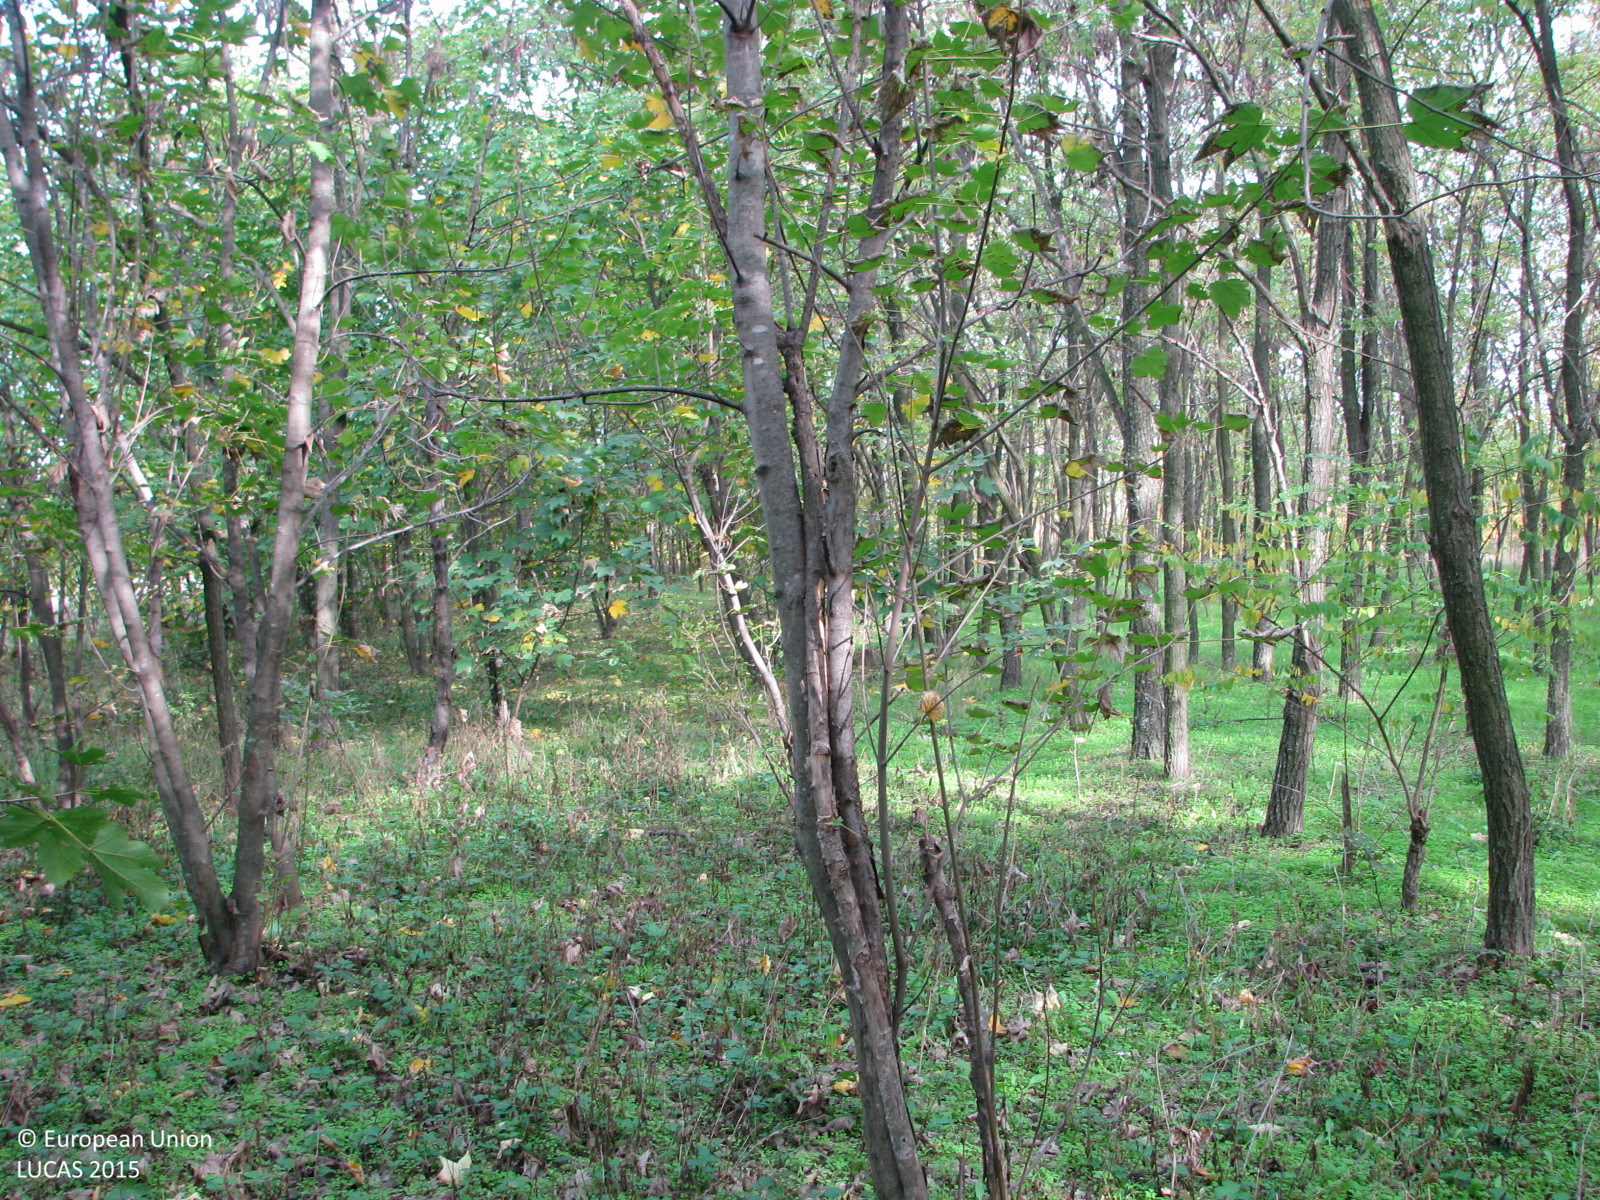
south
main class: Woodland
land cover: Broadleaved woodland
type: mesophytic deciduous forest
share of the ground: 50 - 75 %
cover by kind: broadleaved forest trees 70 %, herbaceous plants 30 %
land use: Forestry
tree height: > 5 m
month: October
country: BG
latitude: 42.4707
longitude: 26.6990
